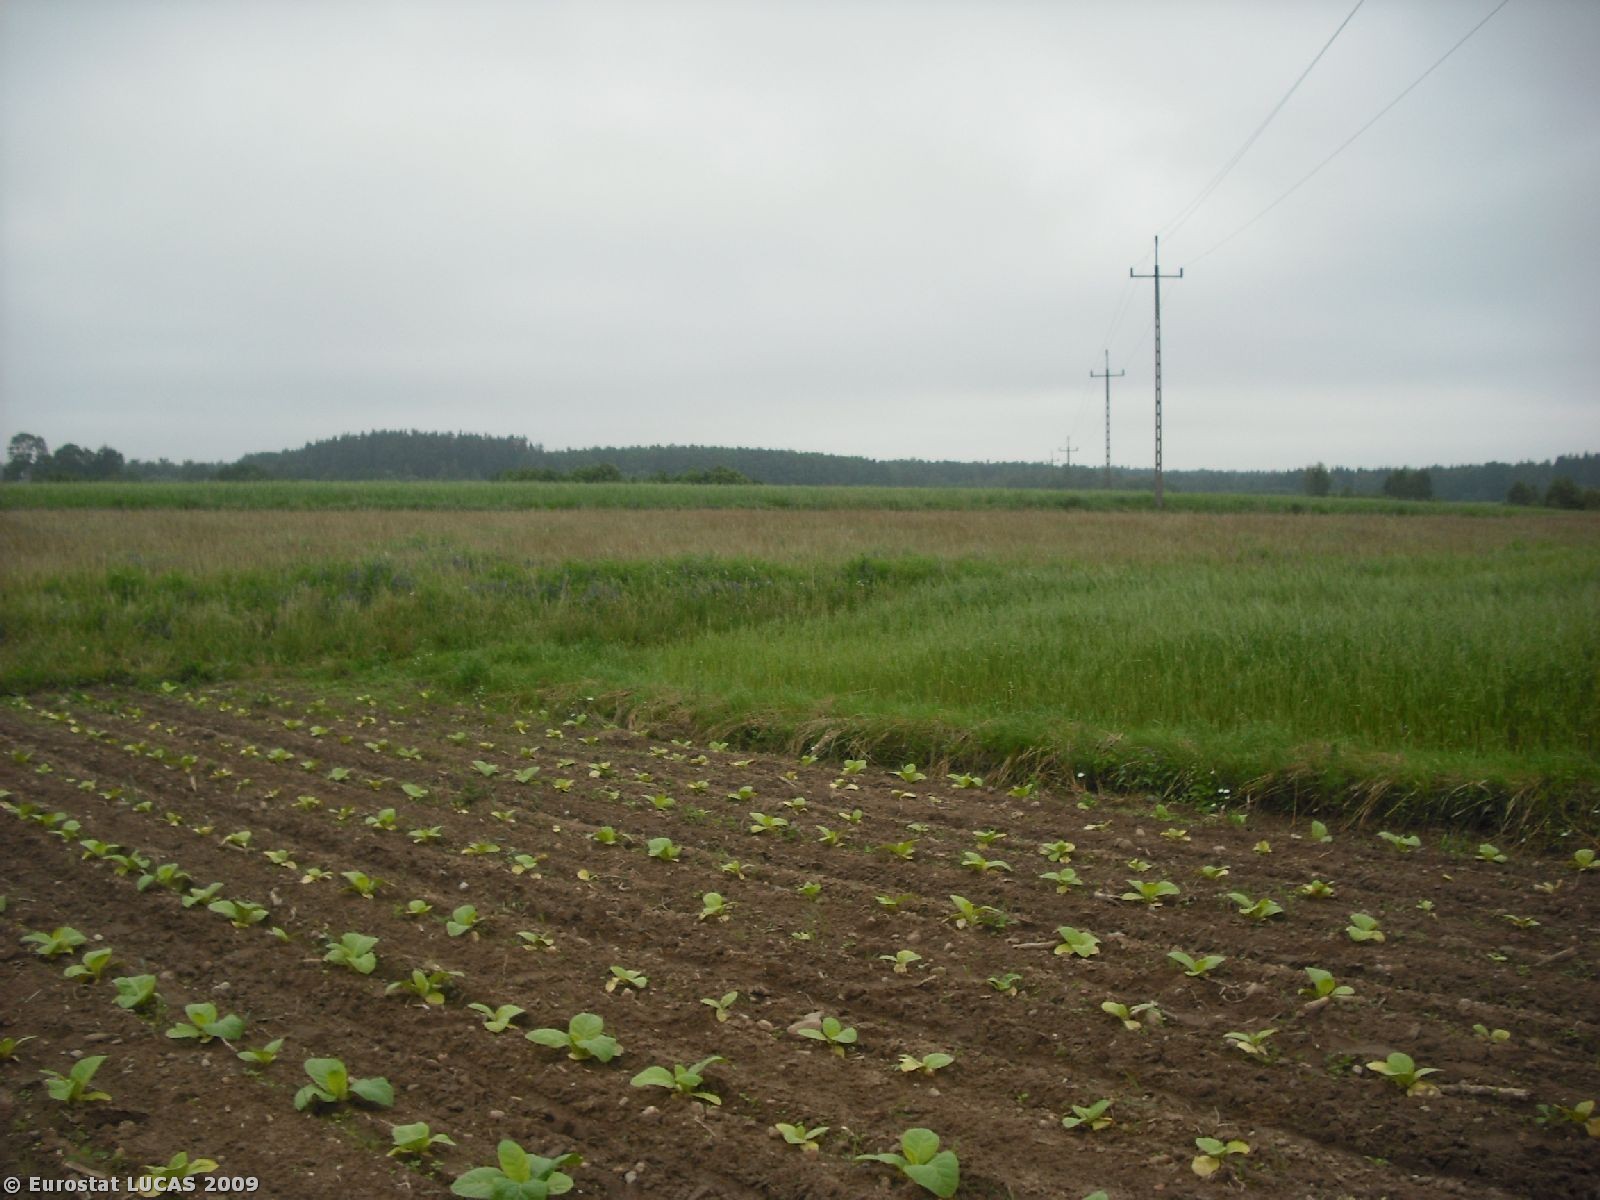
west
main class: Cropland
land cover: Tobacco
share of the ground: 25 - 50 %
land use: Agriculture (excluding fallow land and kitchen gardens)
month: June
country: PL
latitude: 53.9791
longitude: 22.7710
